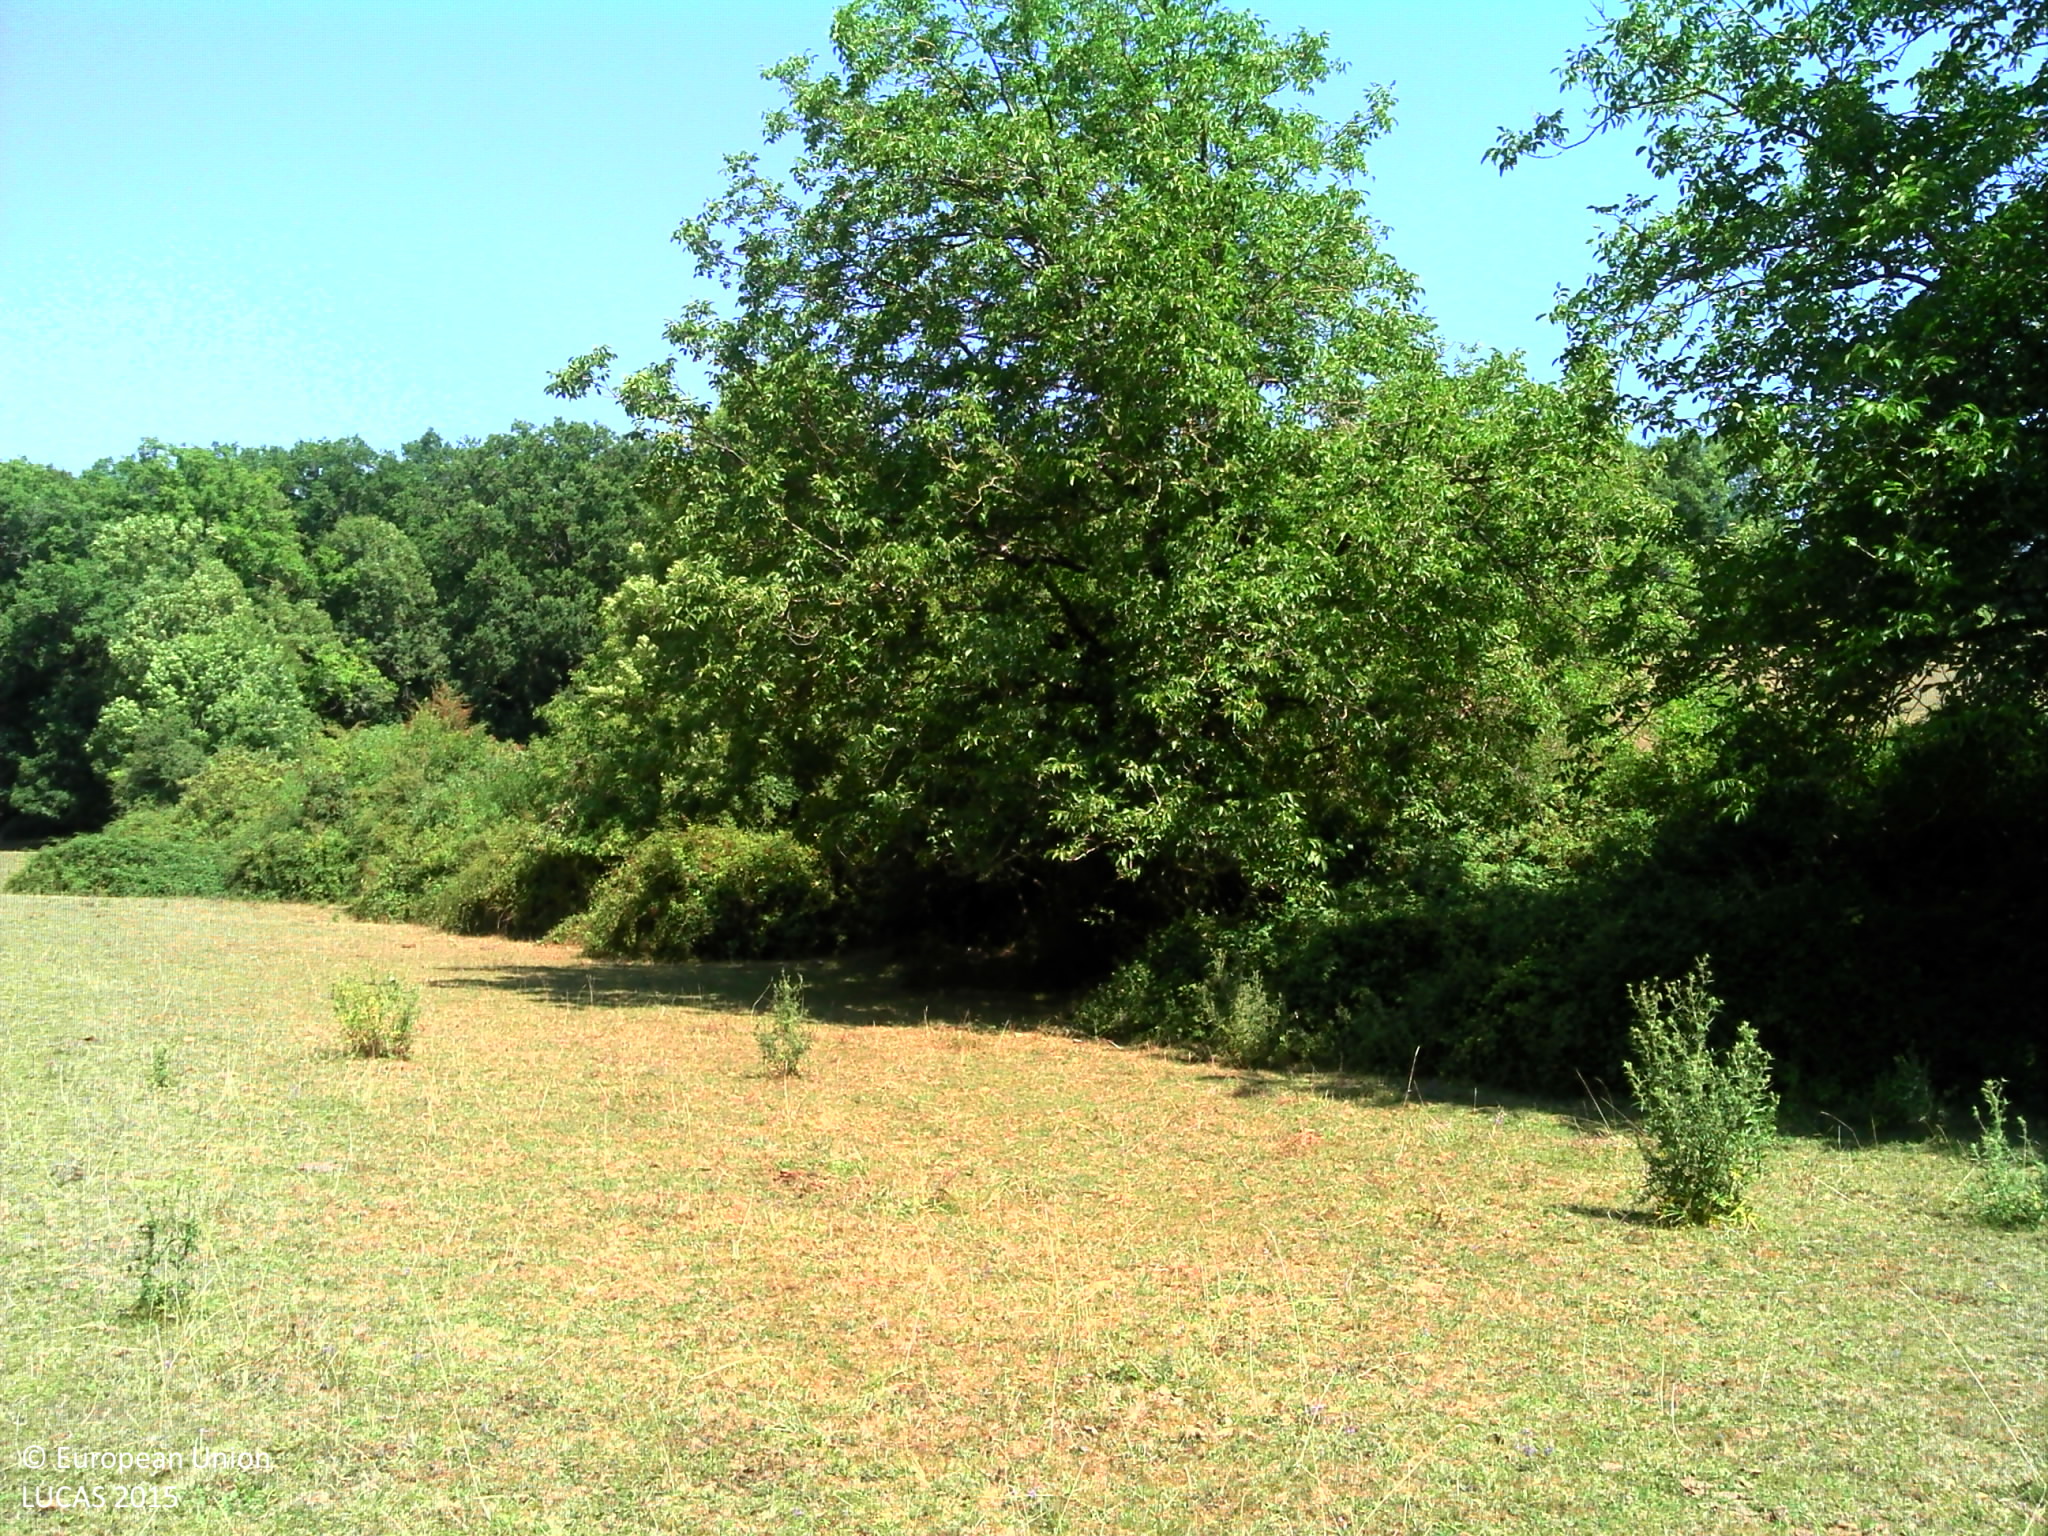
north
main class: Grassland
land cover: Grassland without tree/shrub cover
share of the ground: > 75 %
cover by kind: herbaceous plants 100 %
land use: Agriculture (excluding fallow land and kitchen gardens)
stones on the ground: < 10 %
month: August
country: FR
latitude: 45.3586
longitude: 1.0427
